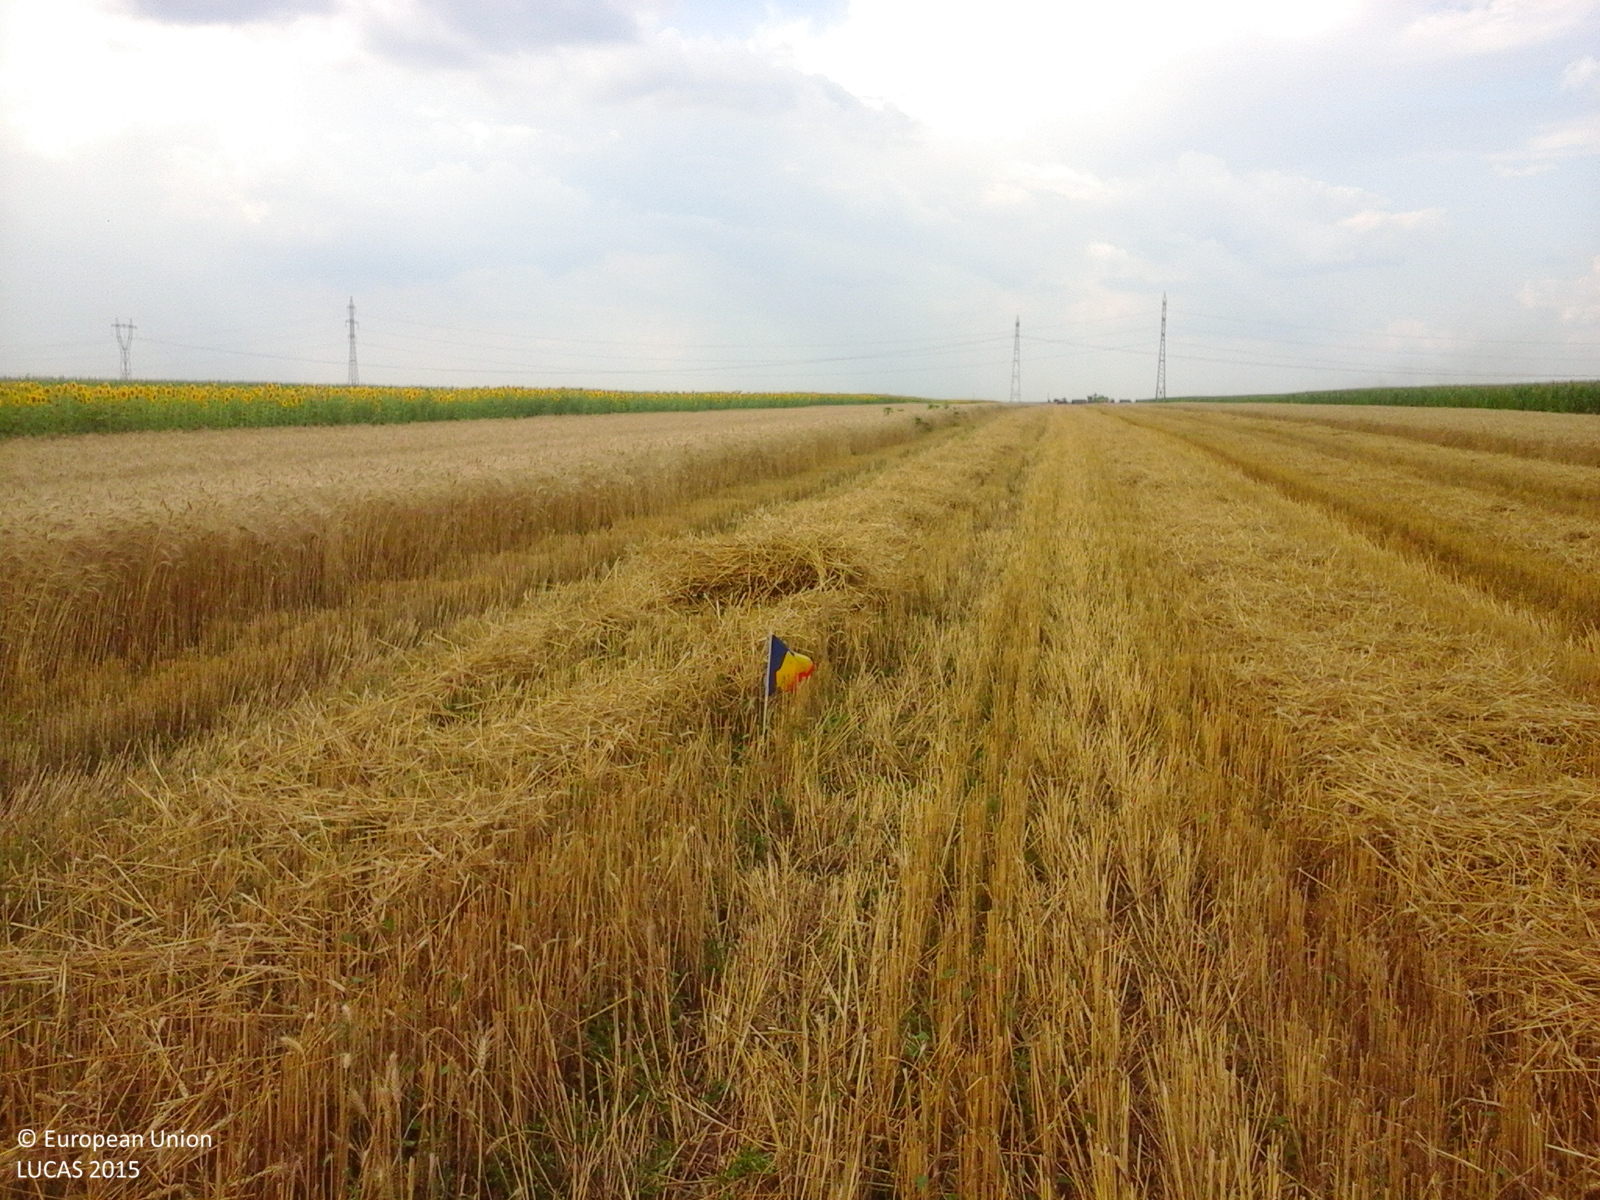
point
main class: Cropland
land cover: Common wheat
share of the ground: > 75 %
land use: Agriculture (excluding fallow land and kitchen gardens)
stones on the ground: < 10 %
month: July
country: RO
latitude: 43.9317
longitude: 25.7241
